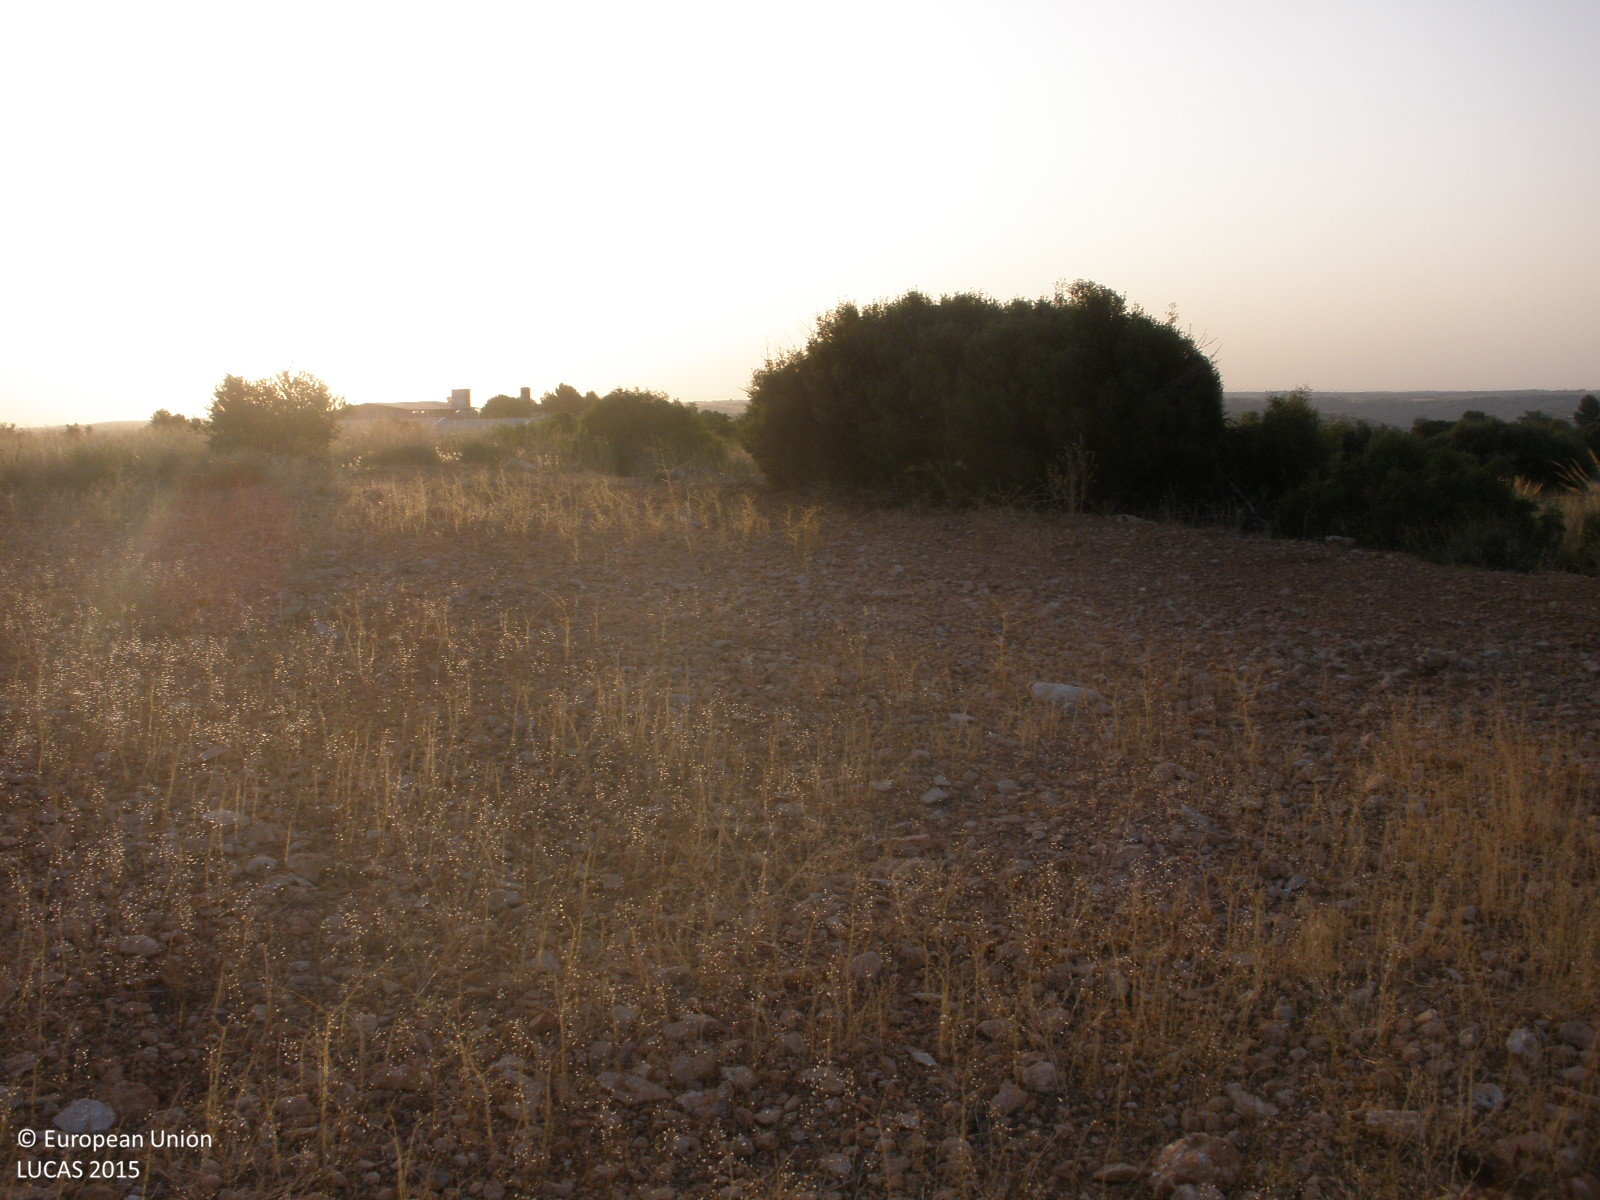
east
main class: Grassland
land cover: Spontaneously vegetated surfaces
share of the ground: > 75 %
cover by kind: herbaceous plants 80 %, unconsolidated bare surface 20 %
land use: Fallow land
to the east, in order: Spontaneously vegetated surfaces; Broadleaved woodland; Shrubland without tree cover; Spontaneously vegetated surfaces; Grass margins; Tracks; Grass margins; Spontaneously vegetated surfaces; Vineyards; Spontaneously vegetated surfaces
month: July
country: ES
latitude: 40.1523
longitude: -3.3776
